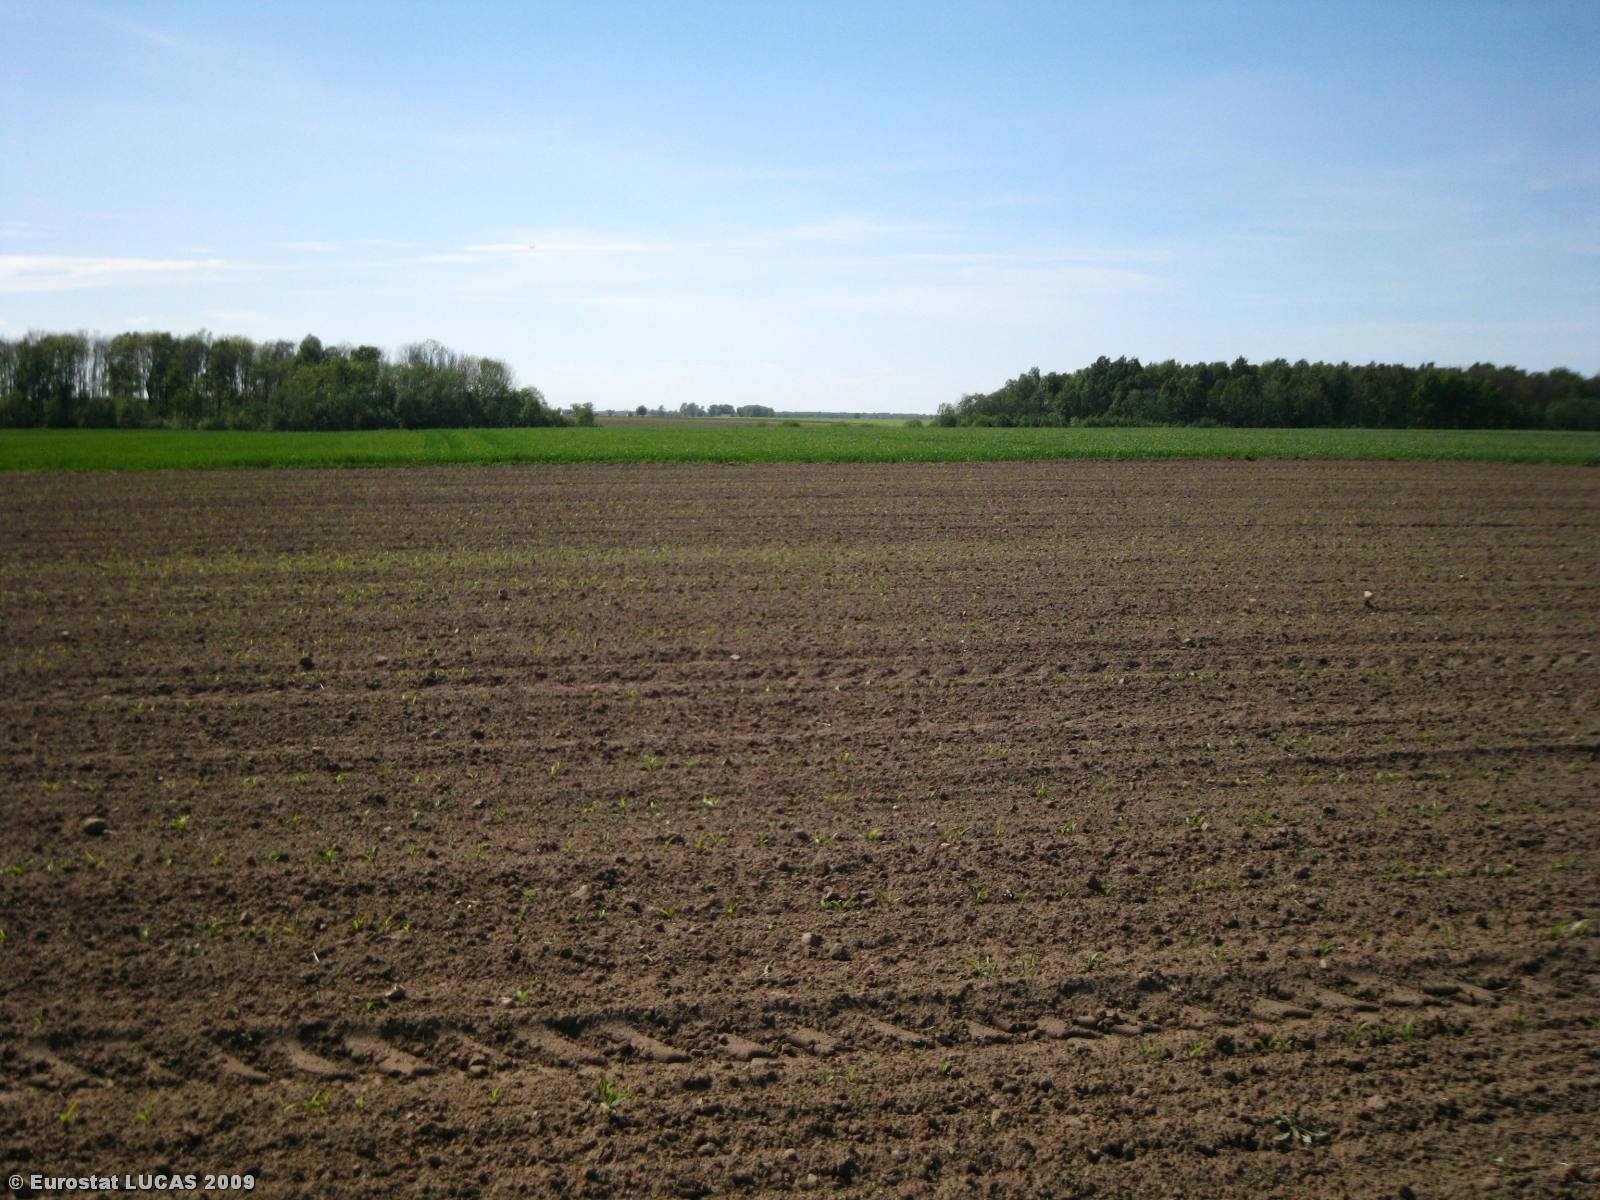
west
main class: Cropland
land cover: Maize
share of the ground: 50 - 75 %
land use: Agriculture (excluding fallow land and kitchen gardens)
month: May
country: LT
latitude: 55.7798
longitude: 24.0075
